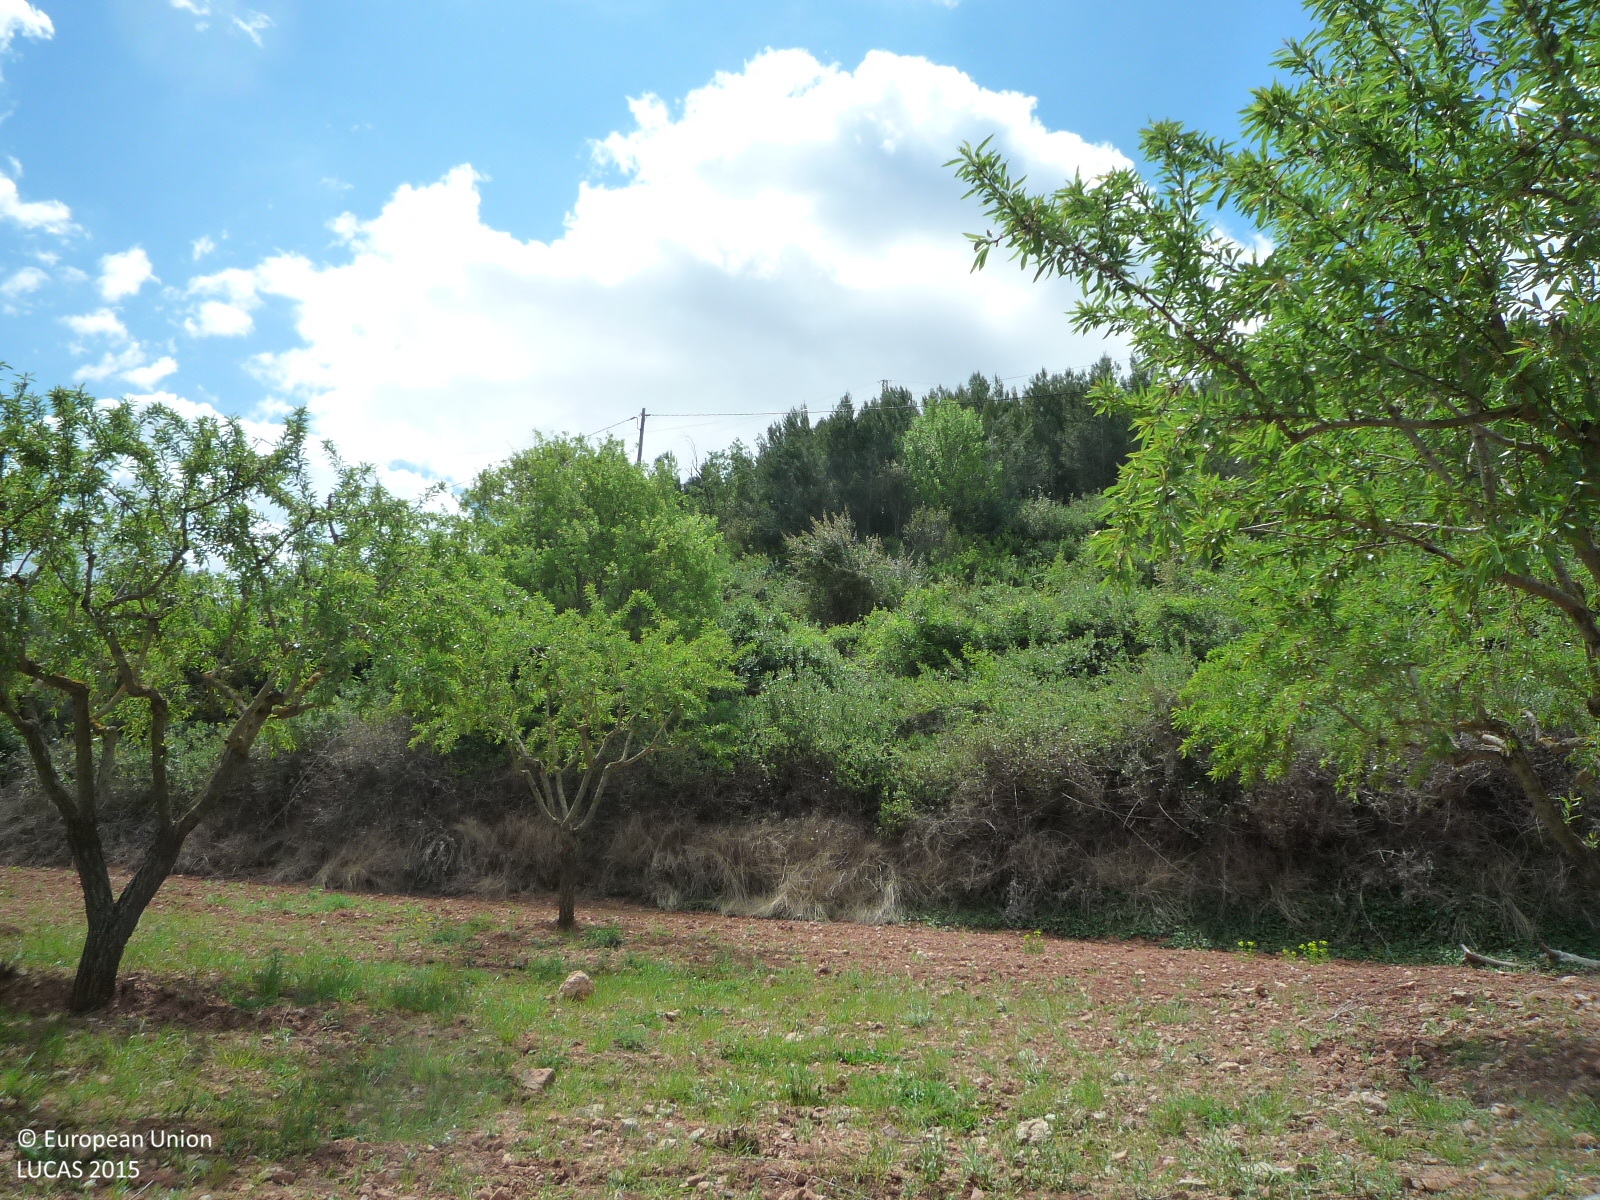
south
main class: Woodland
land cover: Pine dominated coniferous woodland
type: coniferous forest of the mediterranean region
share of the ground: > 75 %
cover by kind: coniferous forest trees 100 %
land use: Semi-natural and natural areas not in use
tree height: < 5 m
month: April
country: ES
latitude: 41.4734
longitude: 1.6462
